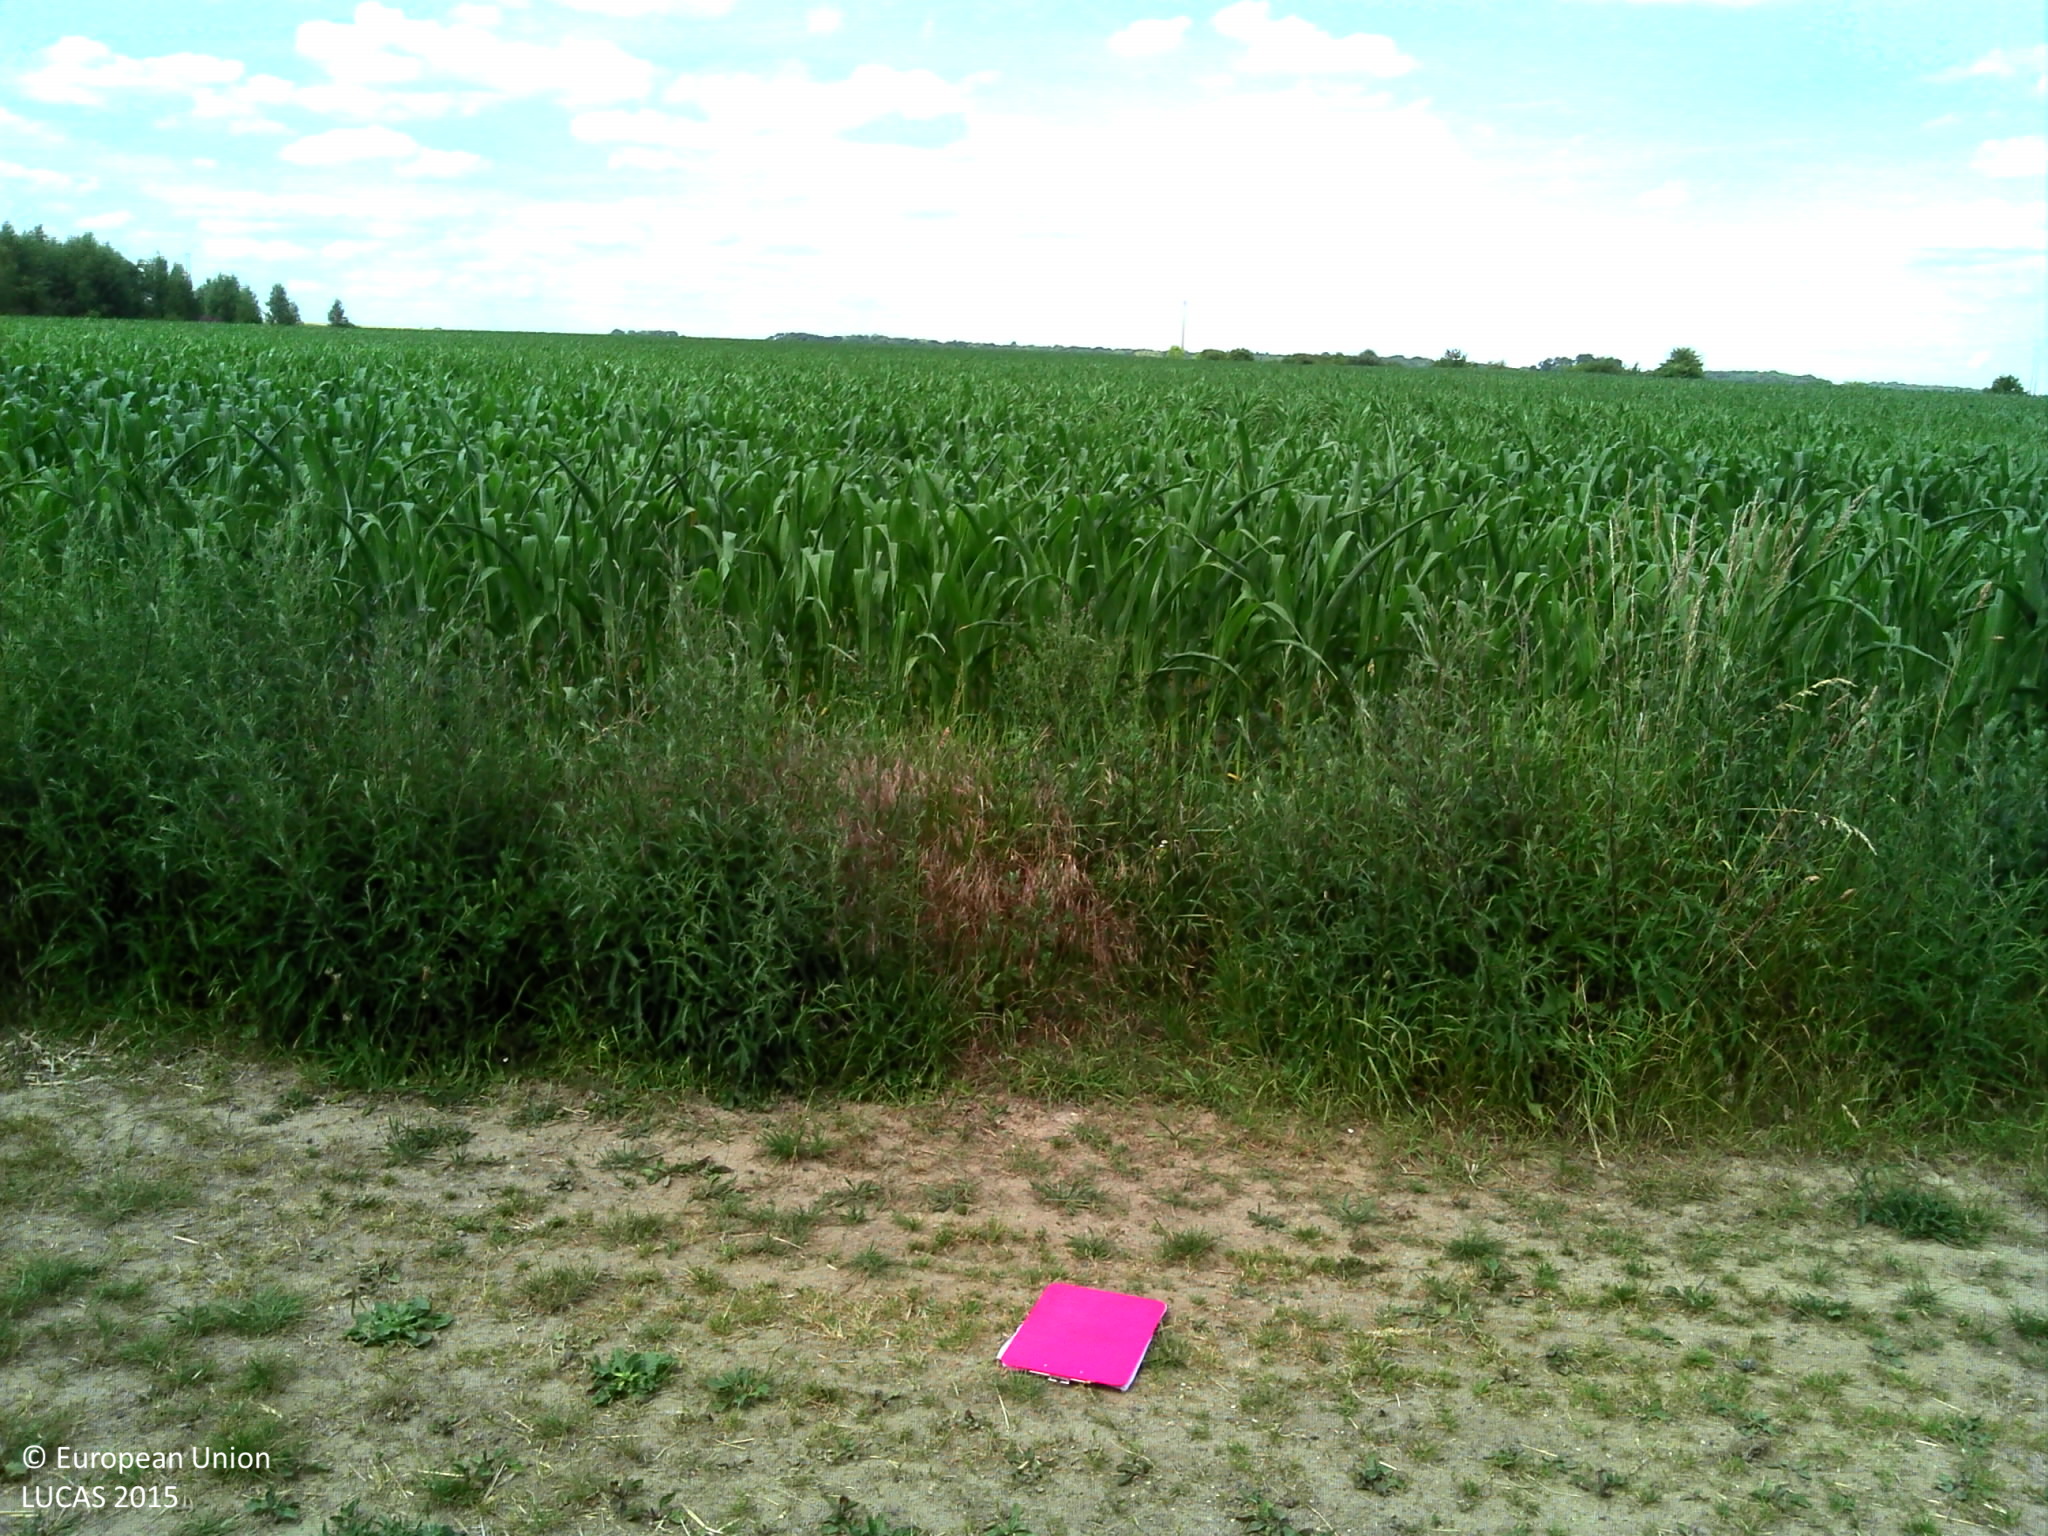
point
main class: Cropland
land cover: Maize
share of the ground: > 75 %
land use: Agriculture (excluding fallow land and kitchen gardens)
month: June
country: FR
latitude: 49.3617
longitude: 2.5393
